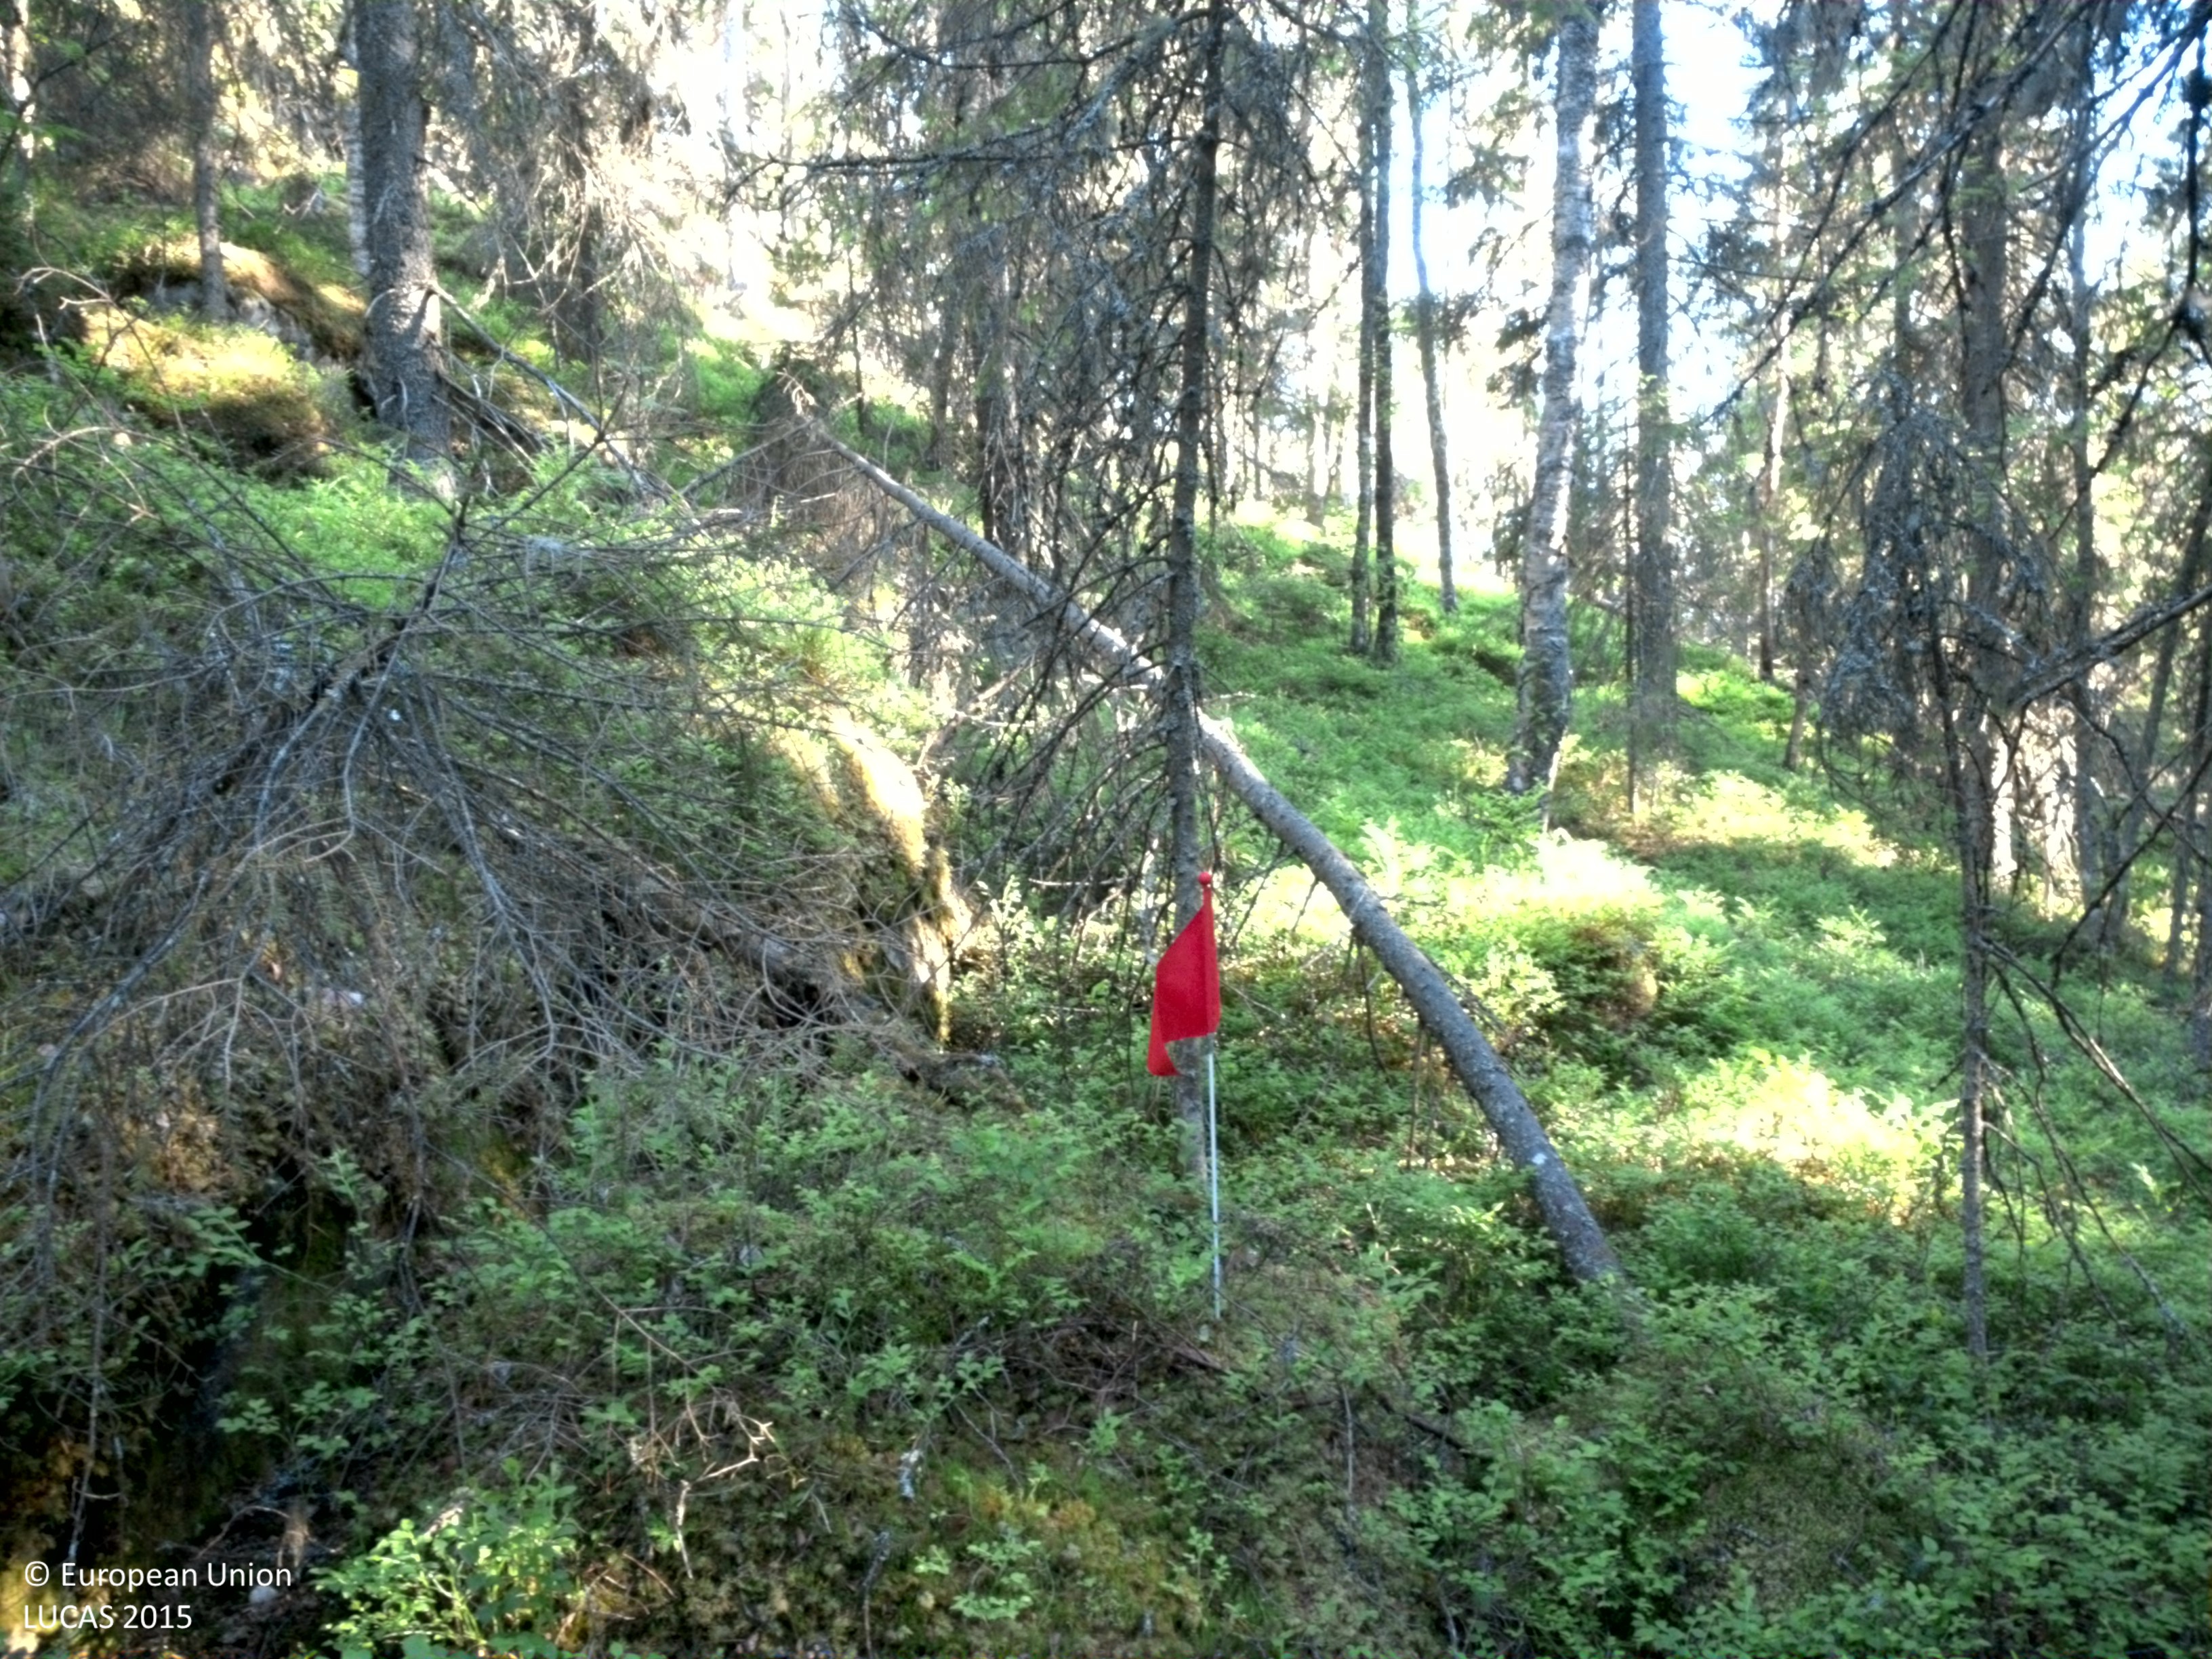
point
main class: Woodland
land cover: Spruce dominated coniferous woodland
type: boreal forest
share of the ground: 50 - 75 %
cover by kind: coniferous forest trees 70 %, shrubs 25 %, lichens and mosses 5 %
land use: Forestry
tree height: > 5 m
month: June
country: SE
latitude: 64.2759
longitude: 20.6563
